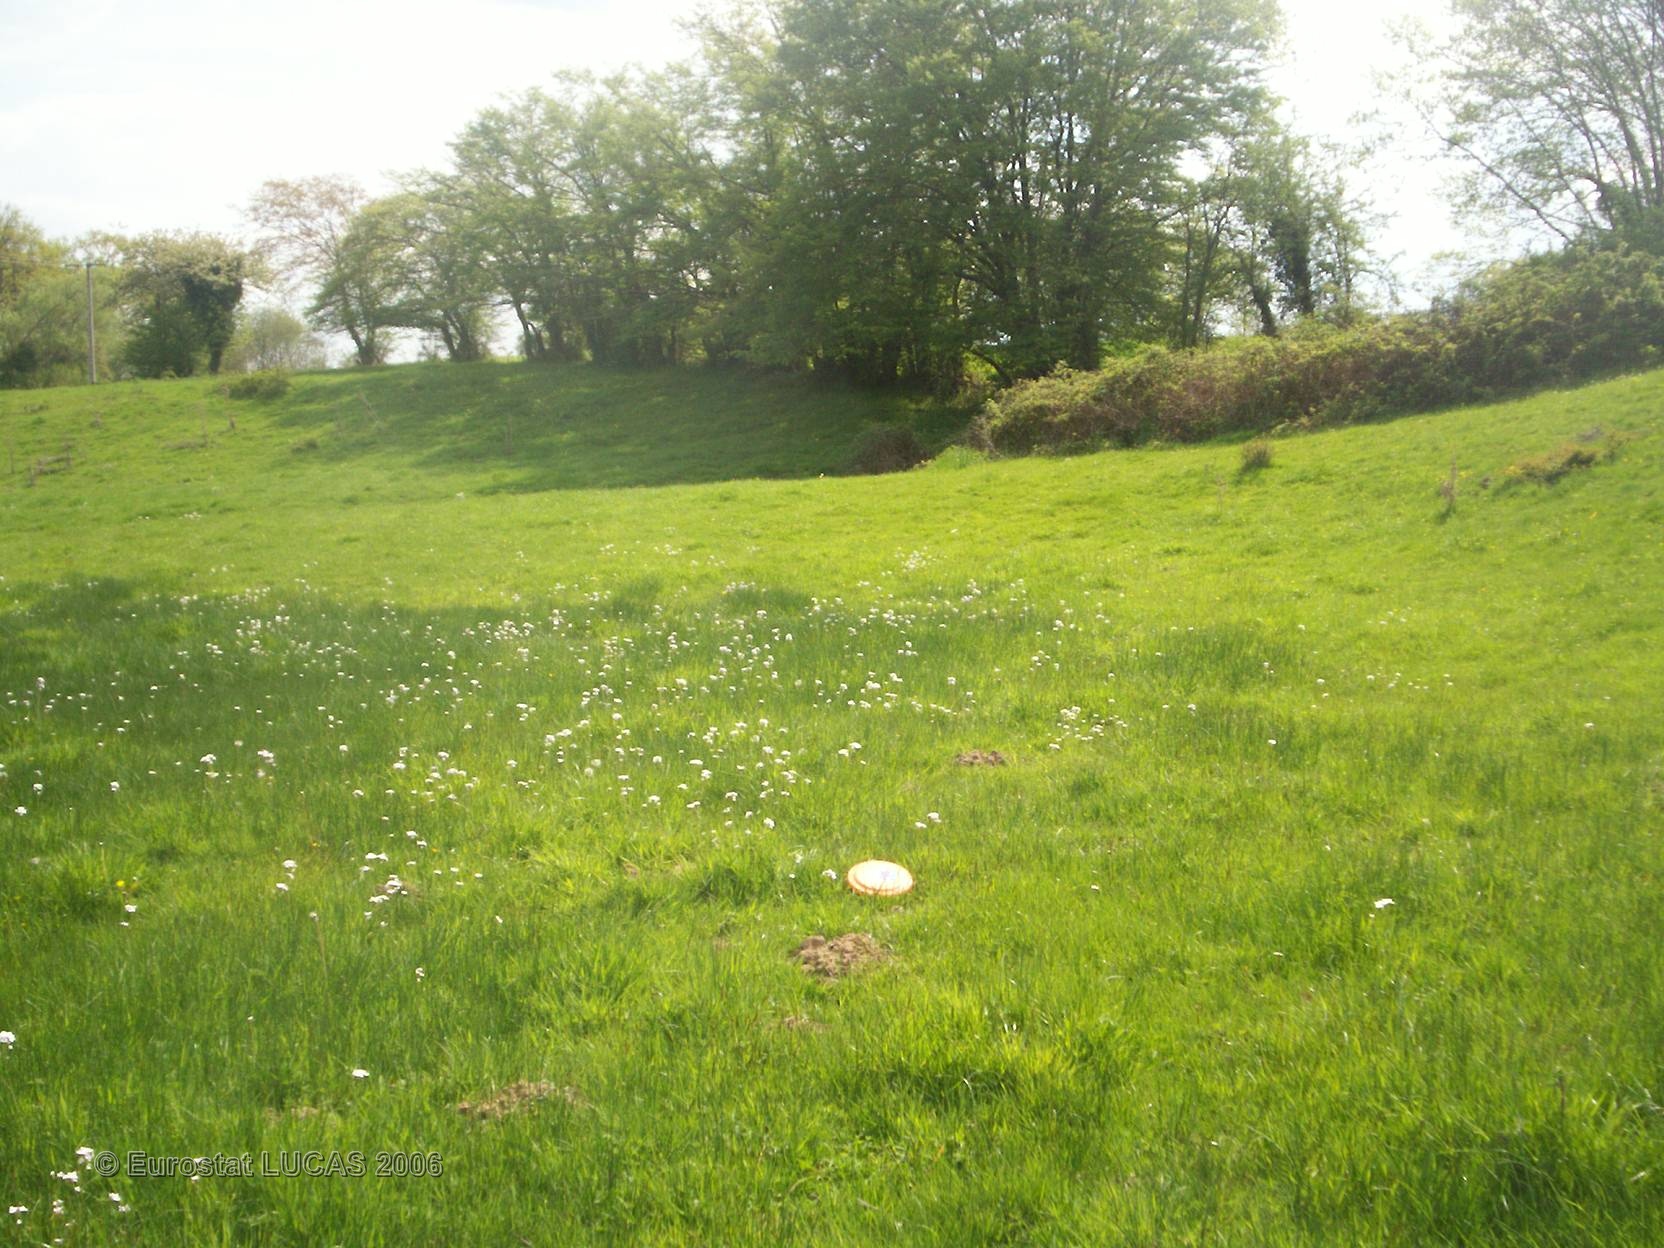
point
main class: Grassland
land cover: Grassland without tree/shrub cover
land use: Agriculture (excluding fallow land and kitchen gardens)
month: May
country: FR
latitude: 46.4022
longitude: 3.1433
